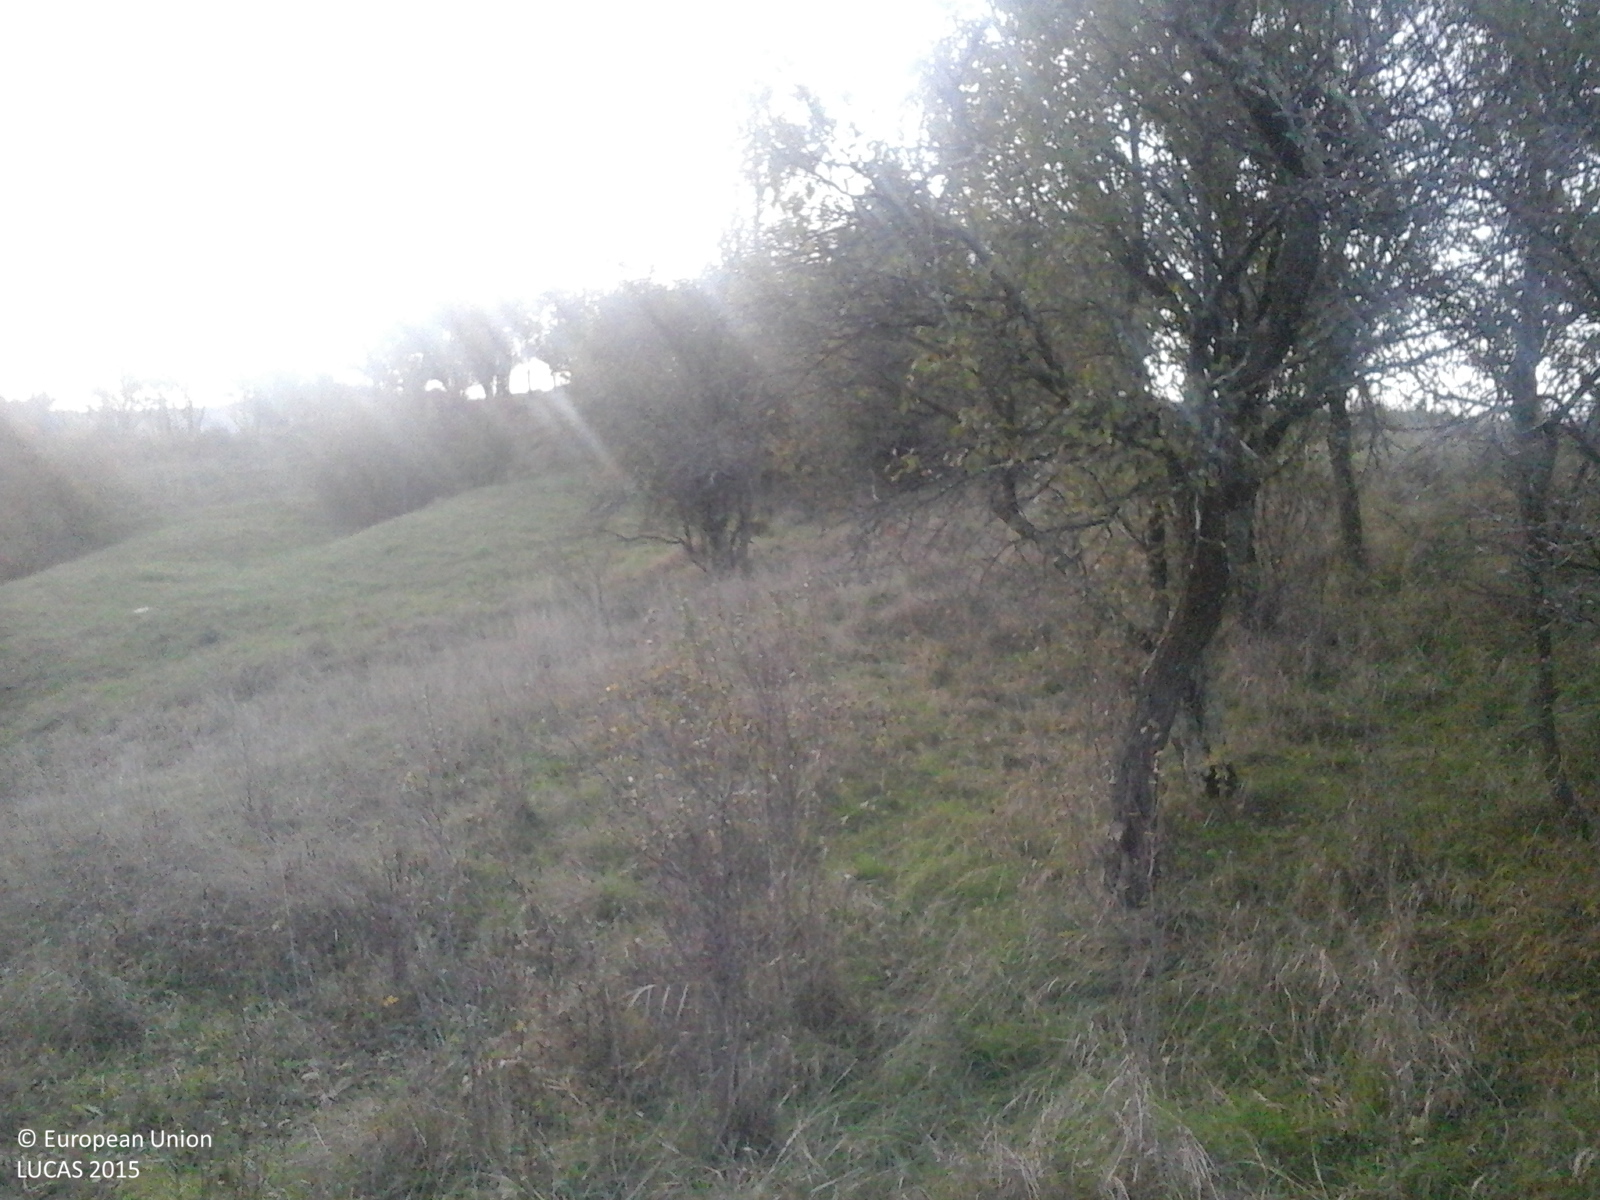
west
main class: Grassland
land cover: Grassland with sparse tree/shrub cover
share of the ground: > 75 %
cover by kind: herbaceous plants 95 %, broadleaved forest trees 5 %
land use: Fallow land
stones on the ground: < 10 %
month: October
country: RO
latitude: 46.1947
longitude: 25.3016
